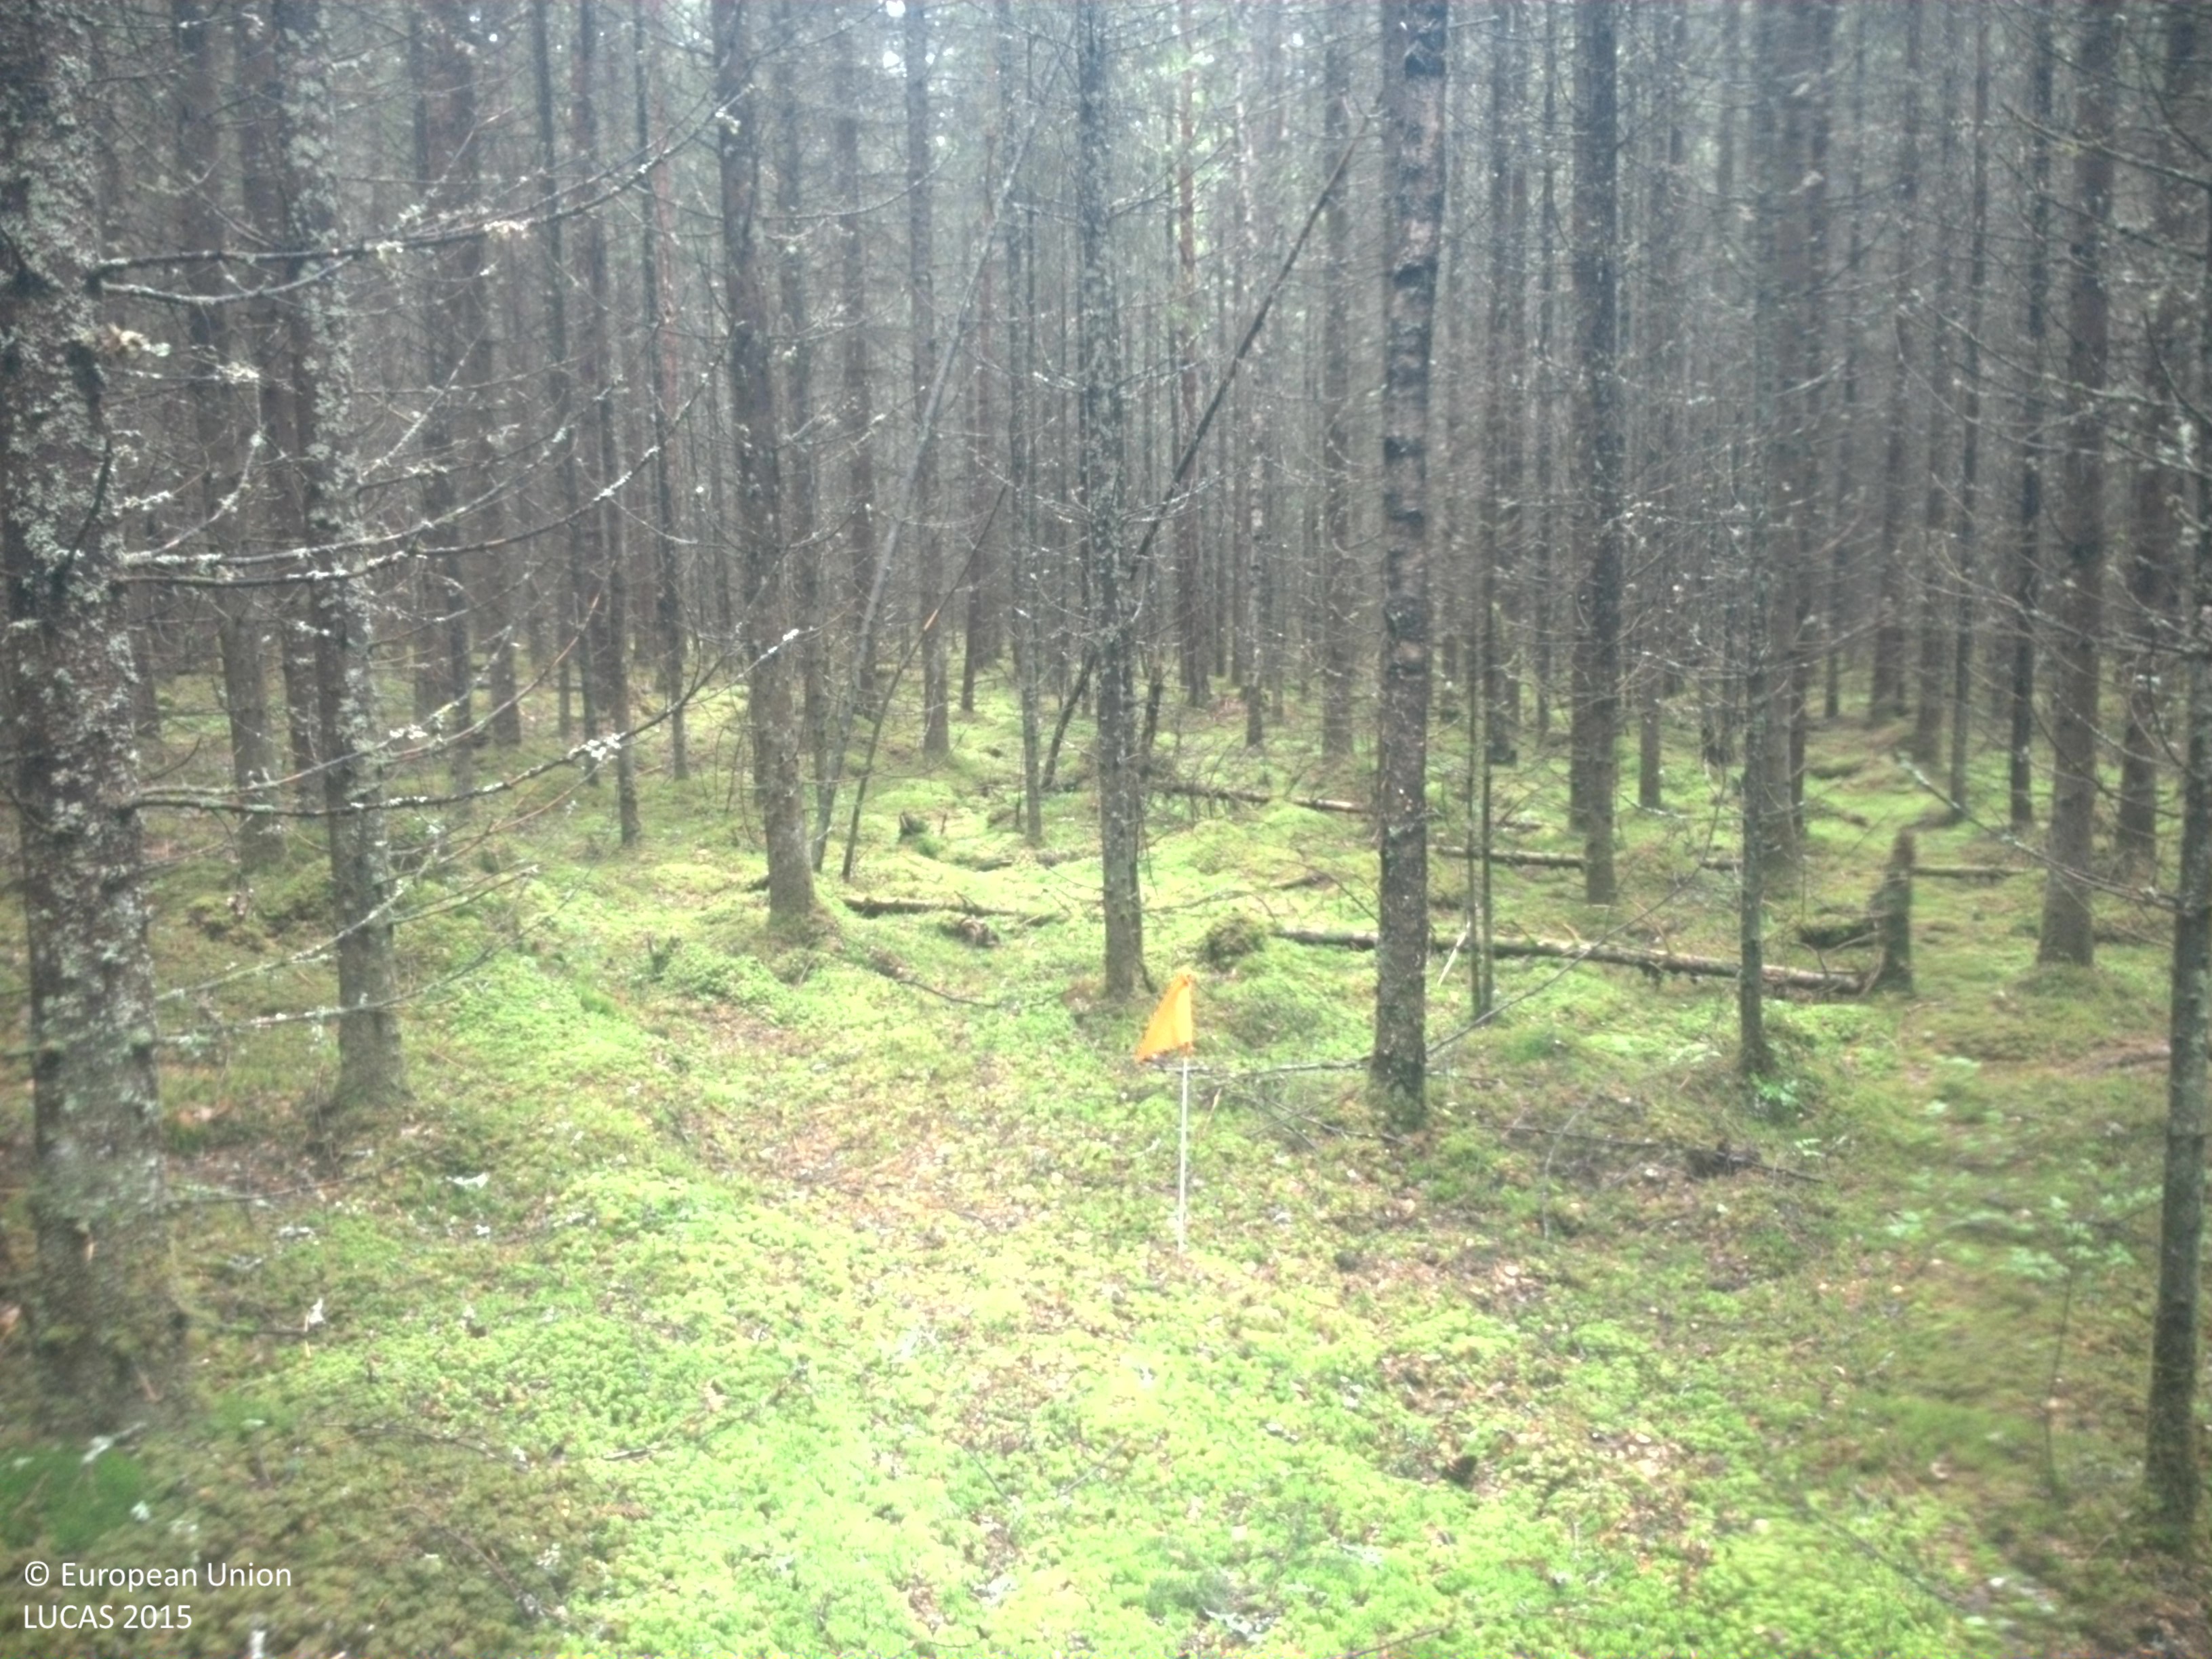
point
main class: Woodland
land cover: Spruce dominated mixed woodland
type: boreal forest
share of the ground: > 75 %
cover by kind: coniferous forest trees 60 %, broadleaved forest trees 25 %, lichens and mosses 15 %
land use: Forestry
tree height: > 5 m
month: June
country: SE
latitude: 59.4254
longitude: 14.4504
